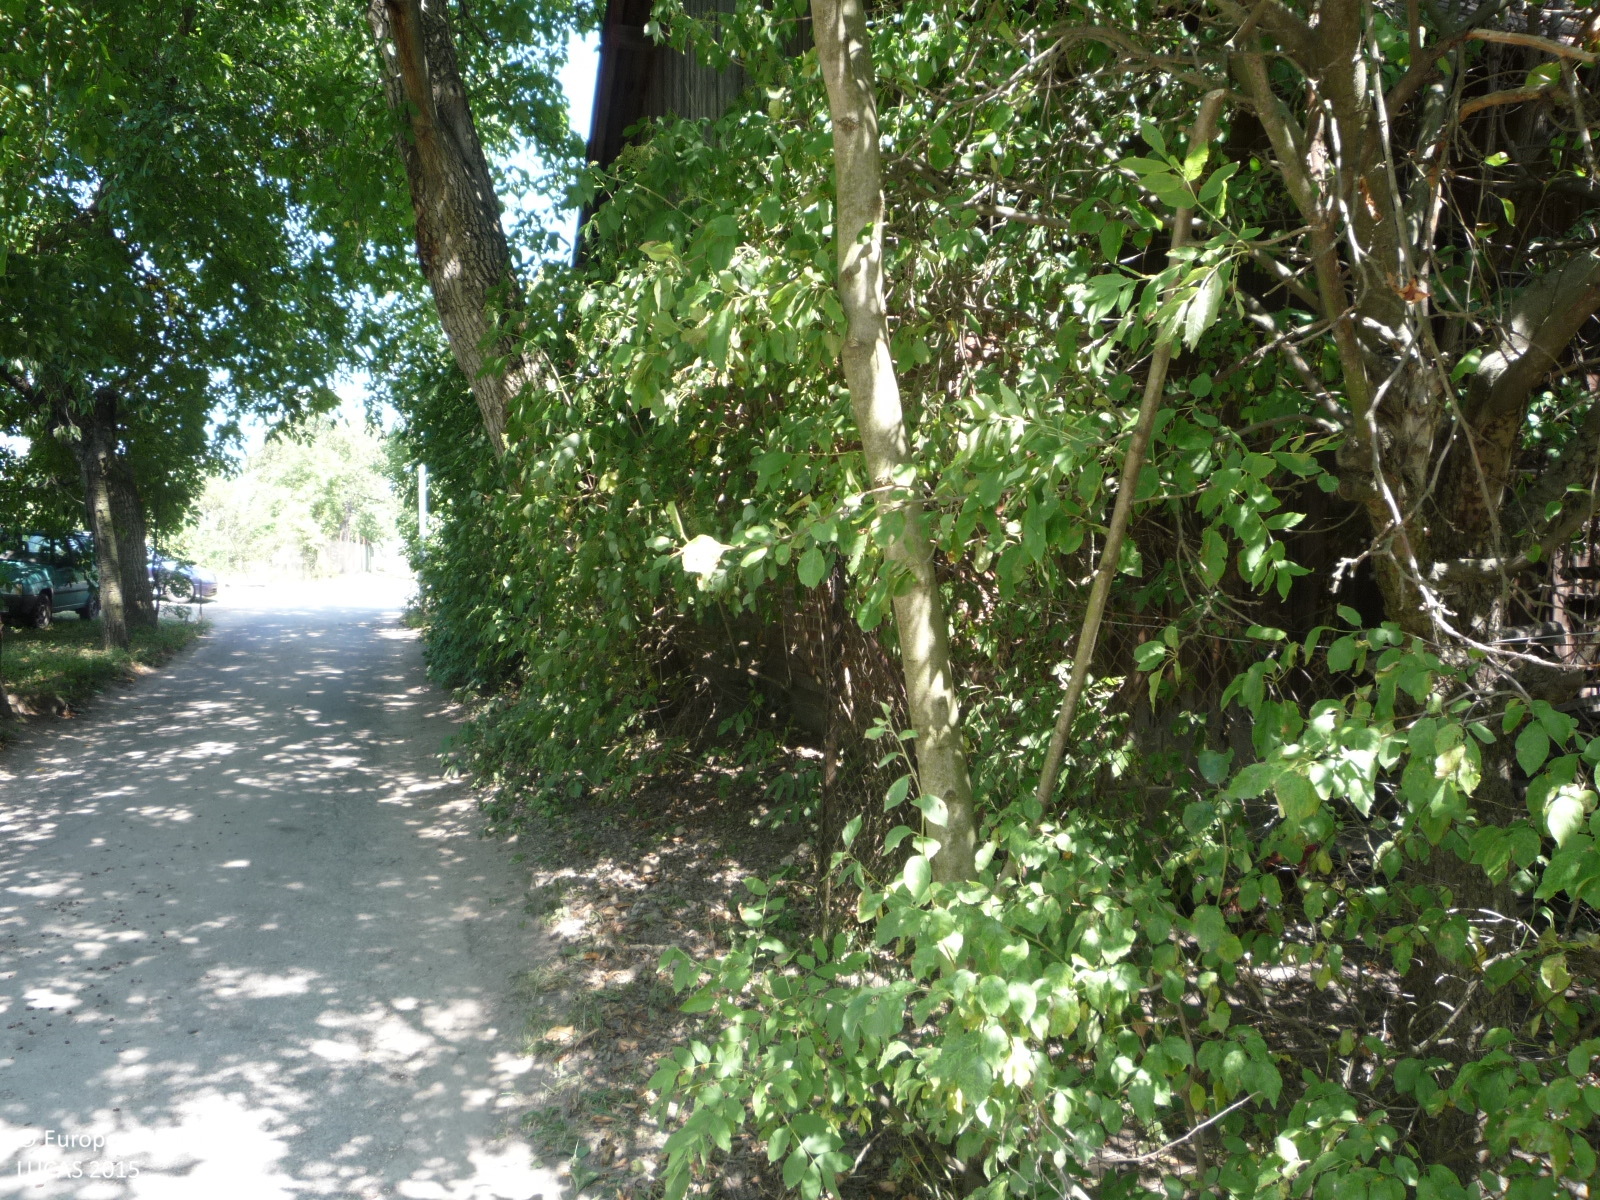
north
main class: Cropland
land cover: Apple fruit
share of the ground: > 75 %
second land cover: Grassland without tree/shrub cover
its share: 10 - 25 %
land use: Kitchen garden
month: August
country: CZ
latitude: 50.5683
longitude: 15.2415
